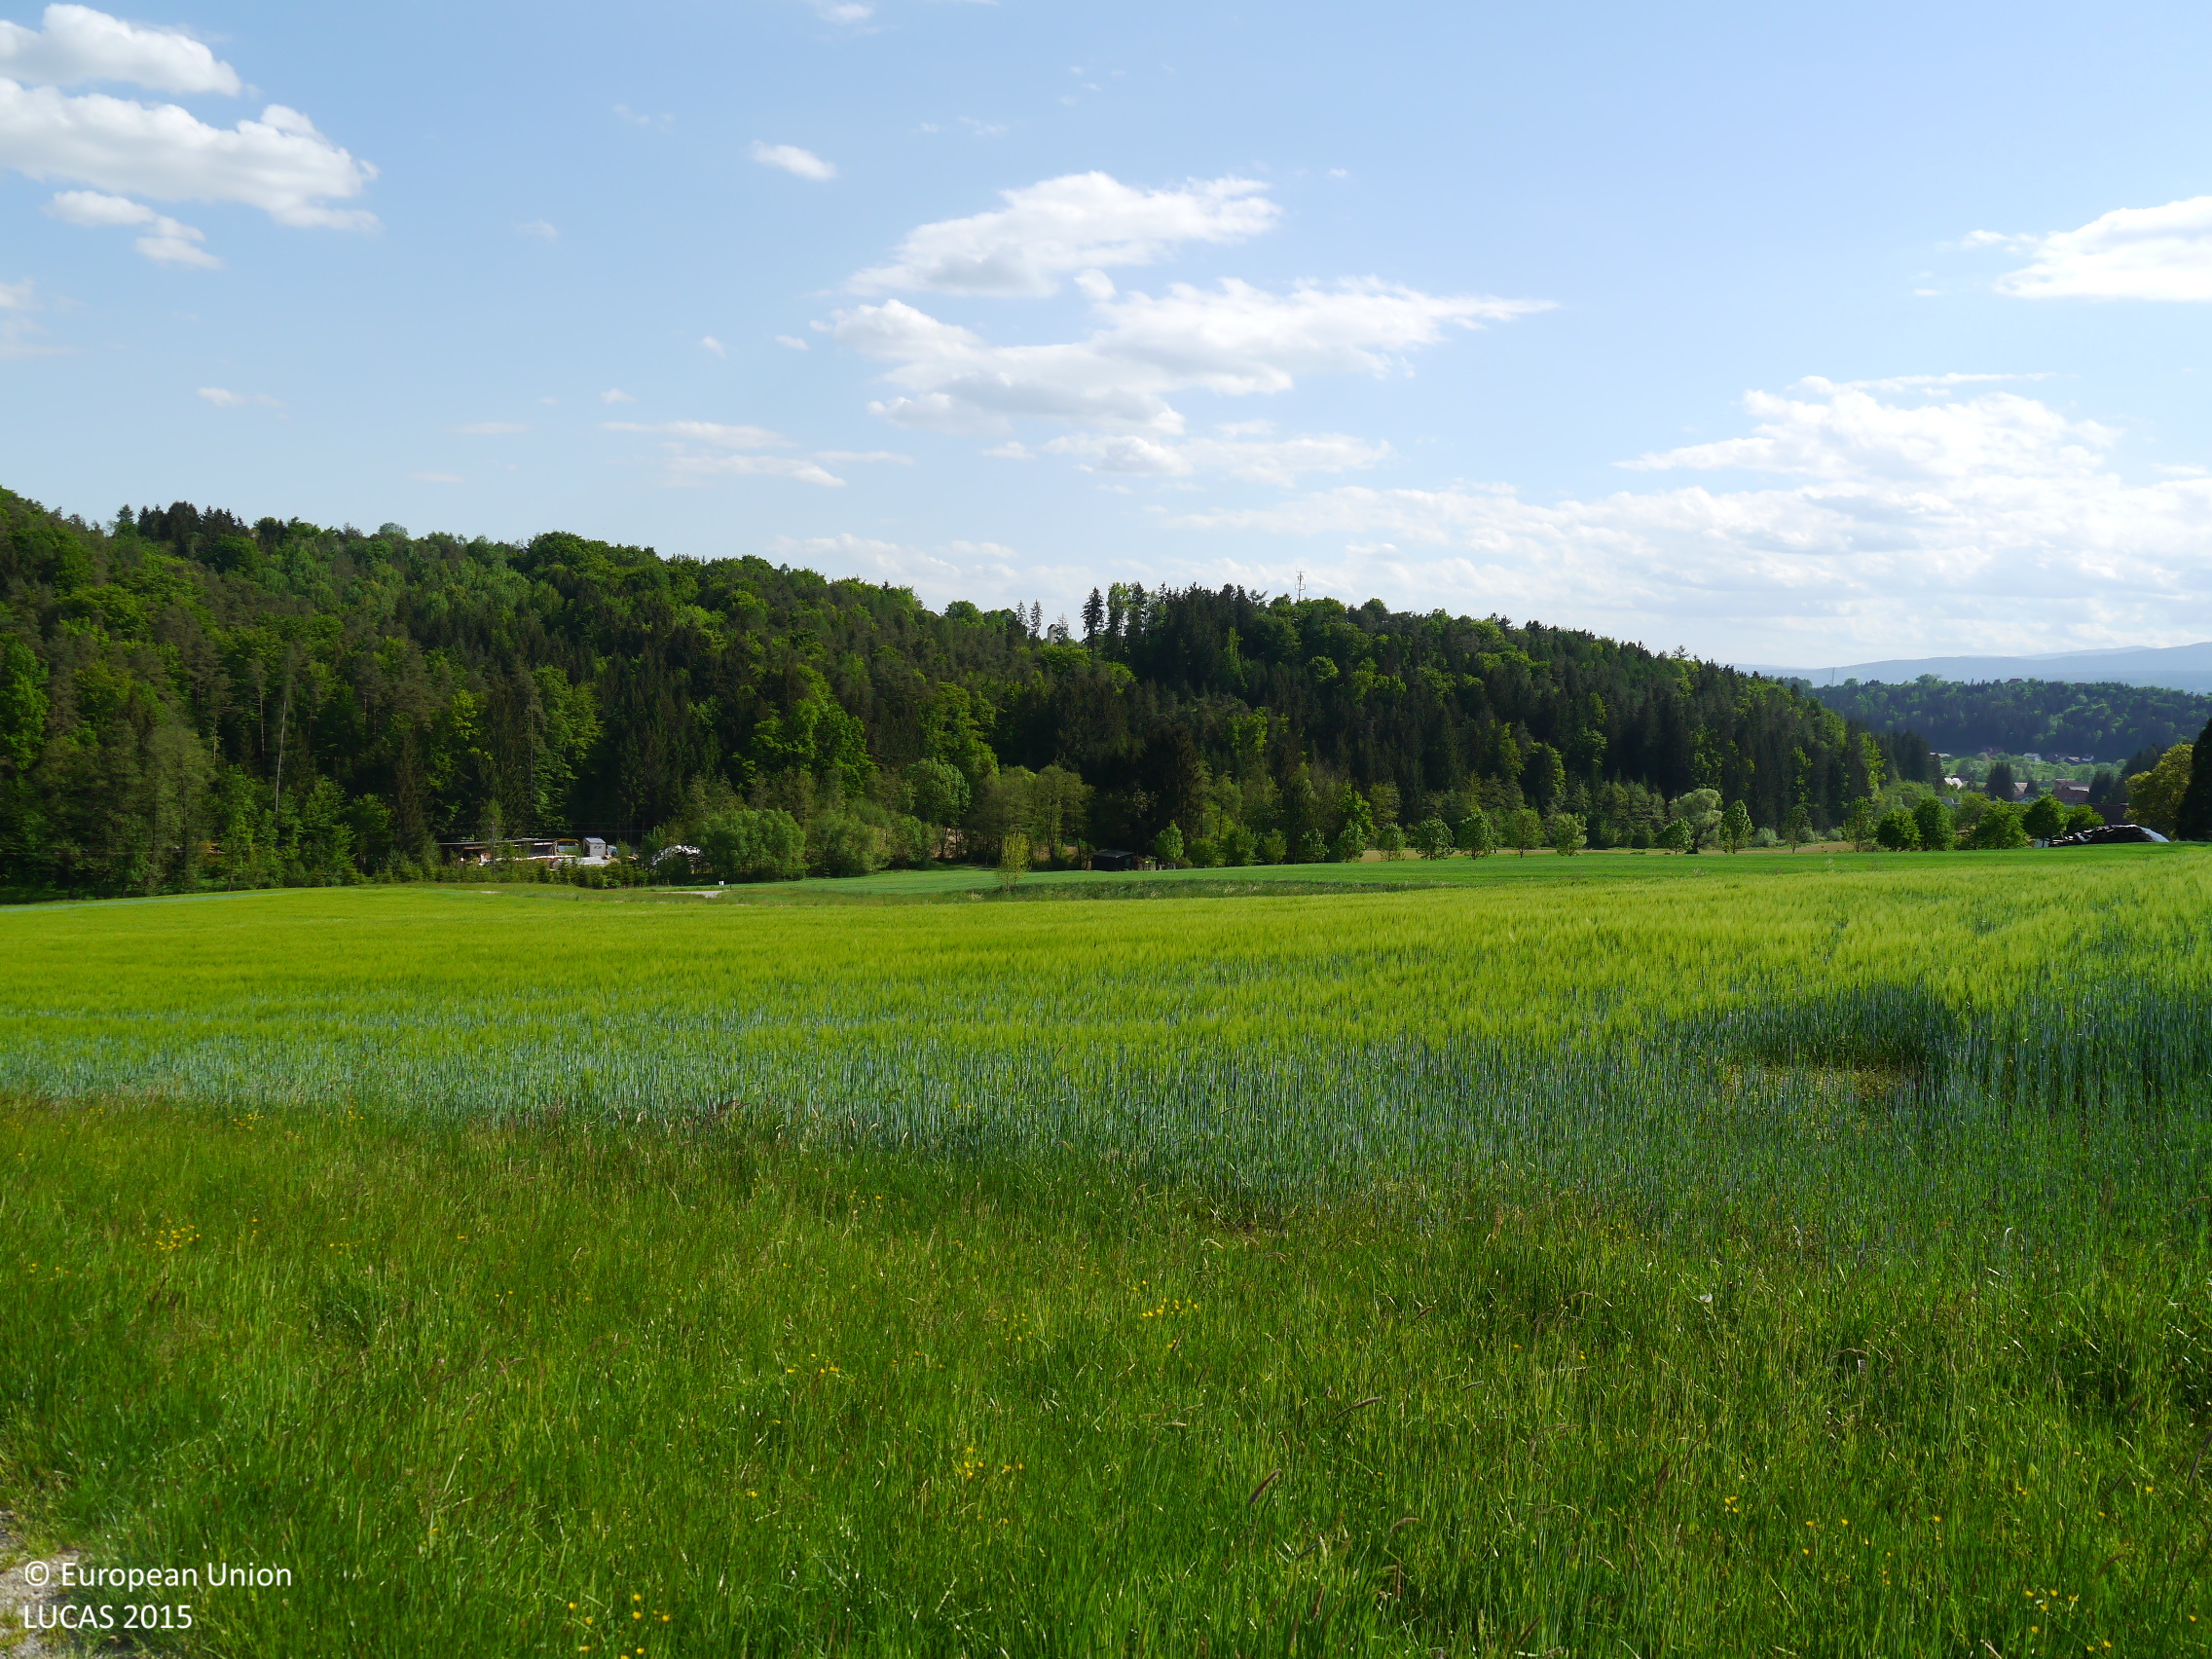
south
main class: Cropland
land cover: Other fresh vegetables
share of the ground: < 10 %
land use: Agriculture (excluding fallow land and kitchen gardens)
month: May
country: AT
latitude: 47.0497
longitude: 15.3044
